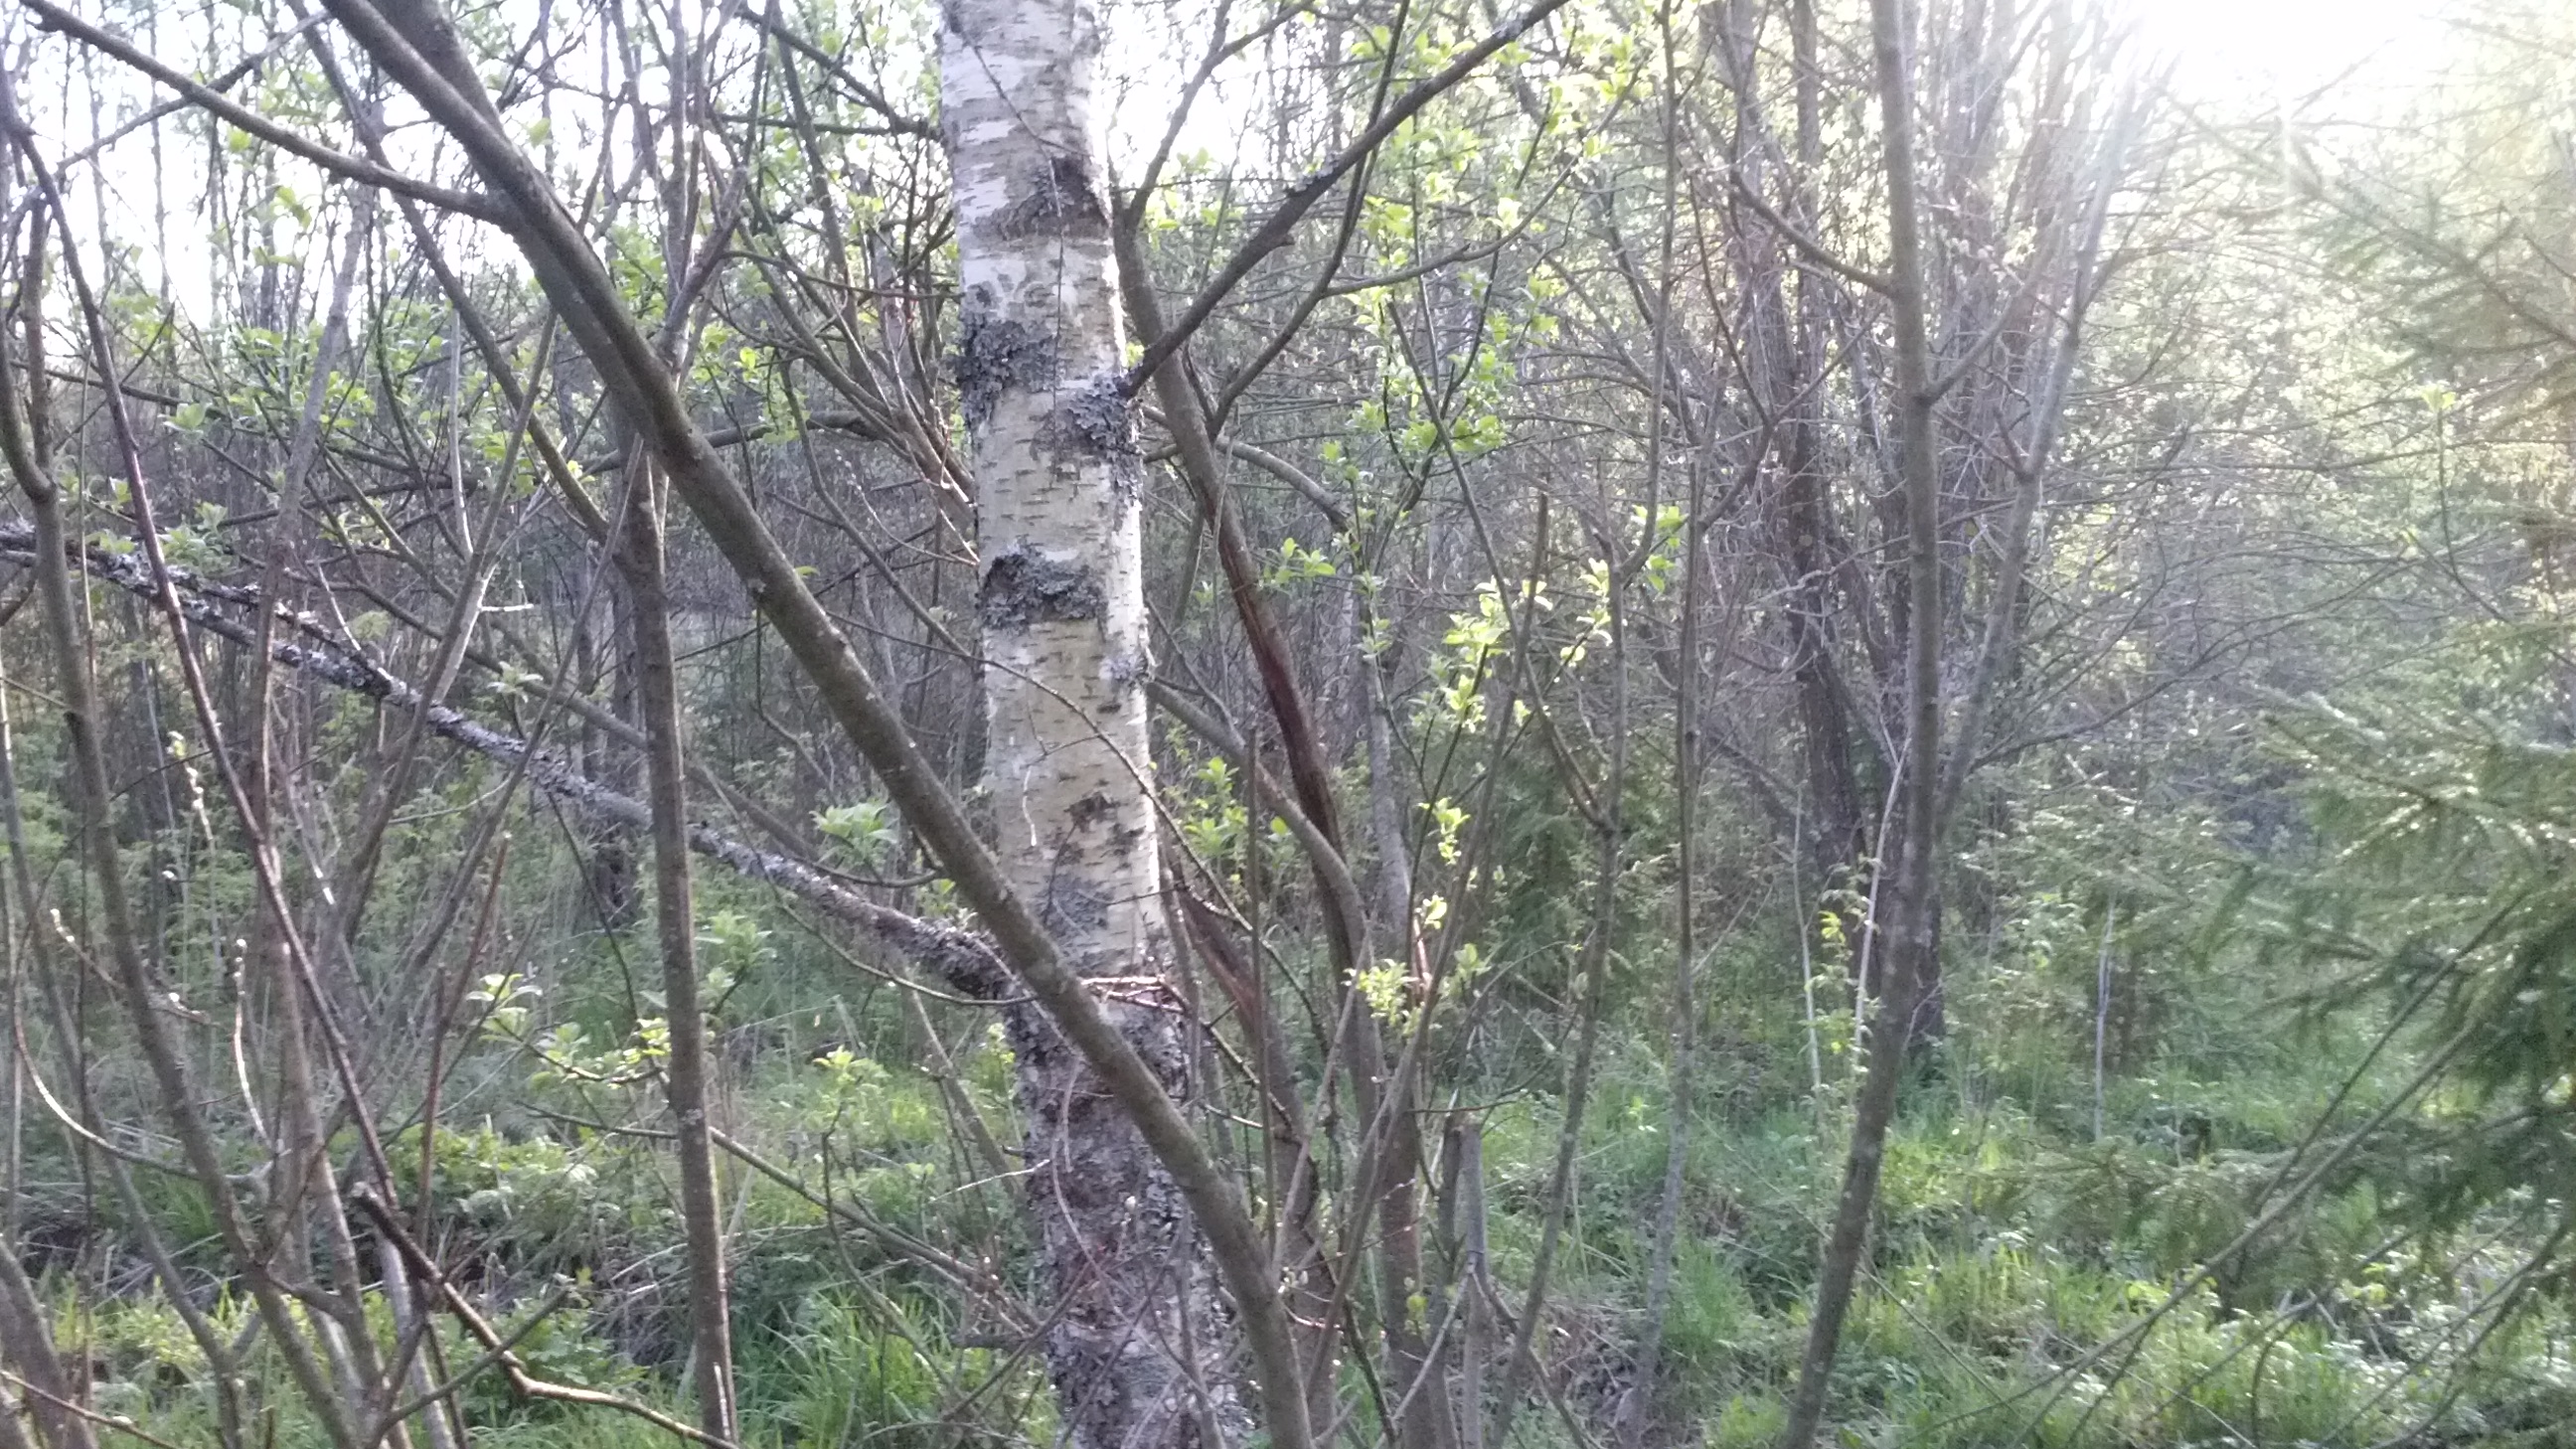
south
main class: Woodland
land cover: Spruce dominated mixed woodland
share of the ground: > 75 %
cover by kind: coniferous forest trees 75 %, broadleaved forest trees 25 %
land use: Forestry
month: May
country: LV
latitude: 56.0926
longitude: 27.2591
